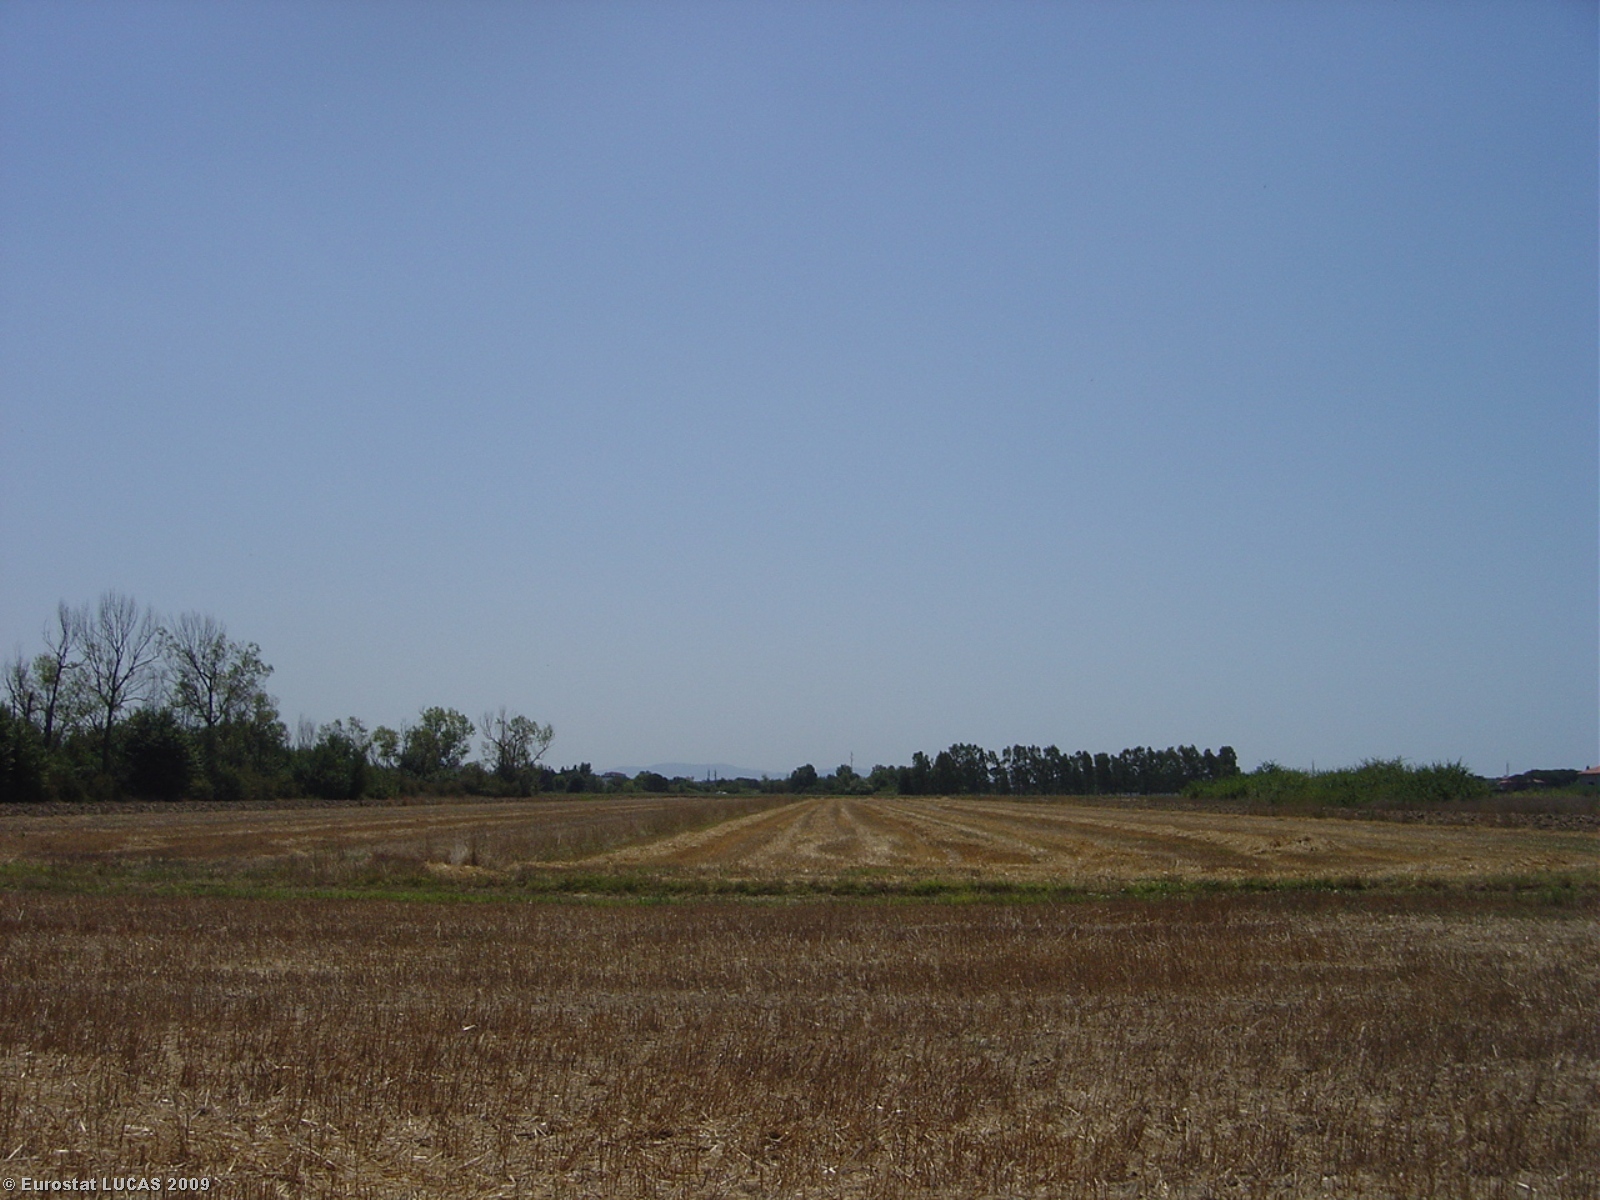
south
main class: Cropland
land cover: Durum wheat
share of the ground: < 10 %
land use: Agriculture (excluding fallow land and kitchen gardens)
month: July
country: IT
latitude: 43.7544
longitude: 10.4088
